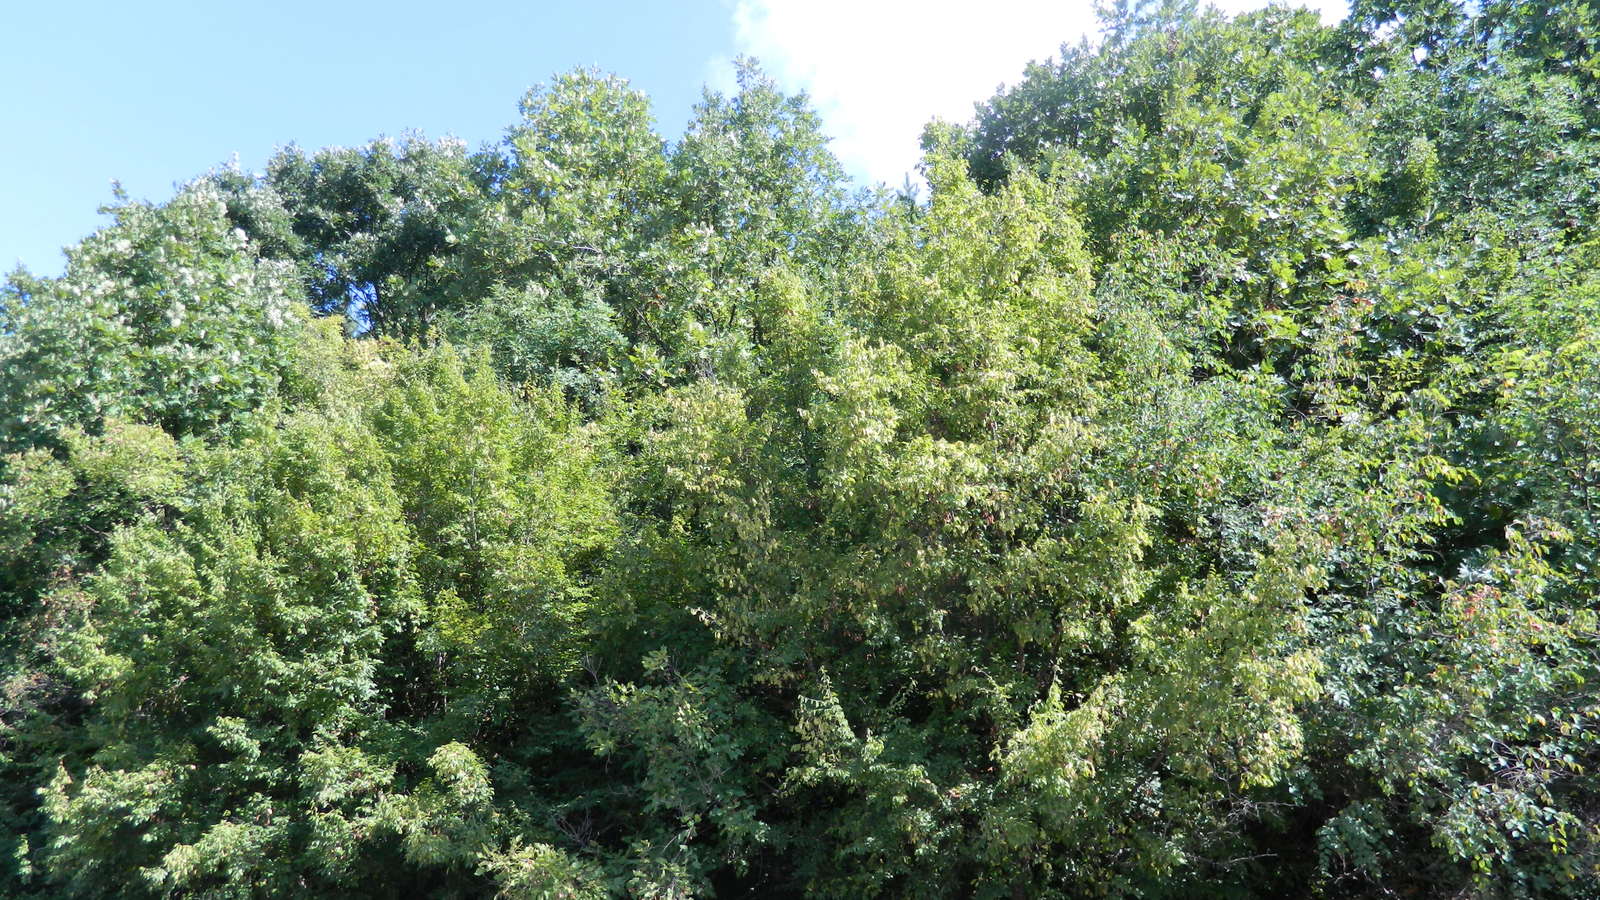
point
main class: Woodland
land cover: Broadleaved woodland
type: mesophytic deciduous forest
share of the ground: > 75 %
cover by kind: broadleaved forest trees 90 %, shrubs 5 %, herbaceous plants 5 %
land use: Forestry
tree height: > 5 m
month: August
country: BG
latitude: 41.6881
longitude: 25.8663
